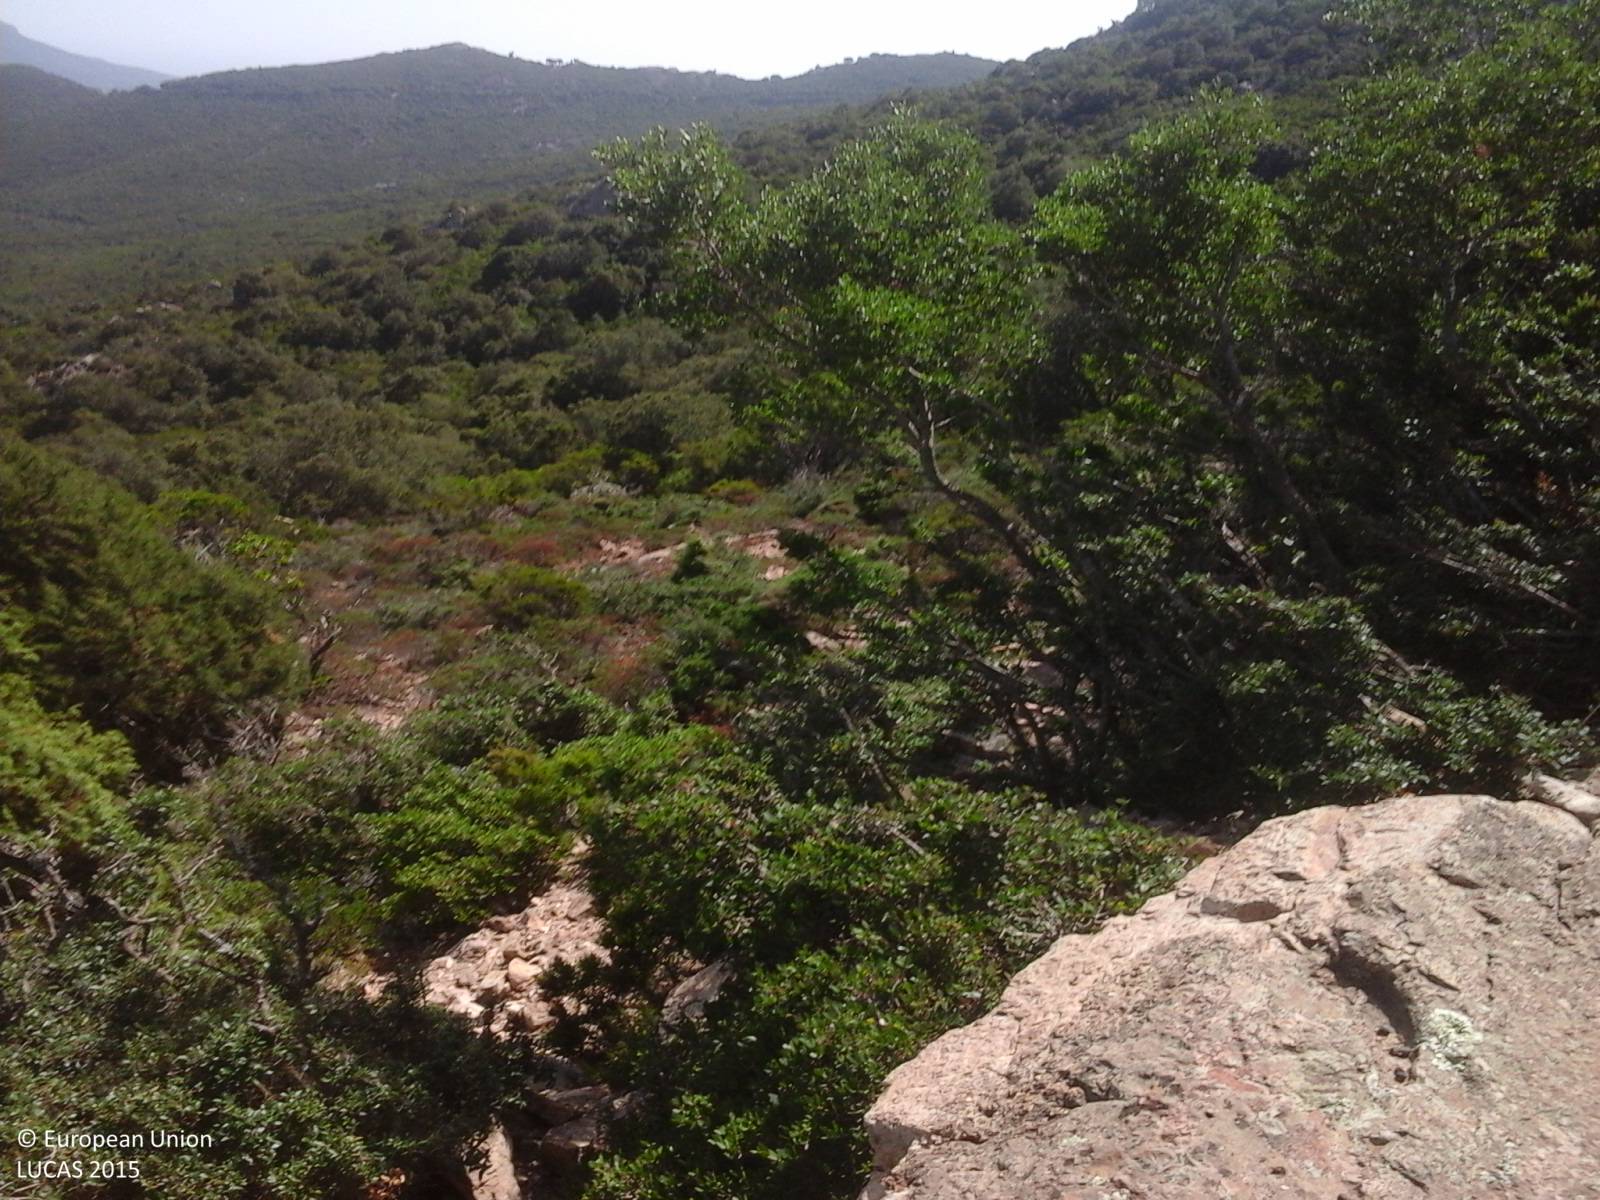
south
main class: Woodland
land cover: Broadleaved woodland
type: broadleaved evergreen forest
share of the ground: > 75 %
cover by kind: broadleaved forest trees 40 %, consolidated bare surface 30 %, unconsolidated bare surface 20 %, shrubs 5 %, herbaceous plants 5 %
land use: Semi-natural and natural areas not in use
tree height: > 5 m
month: September
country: IT
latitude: 40.0674
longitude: 9.6152
